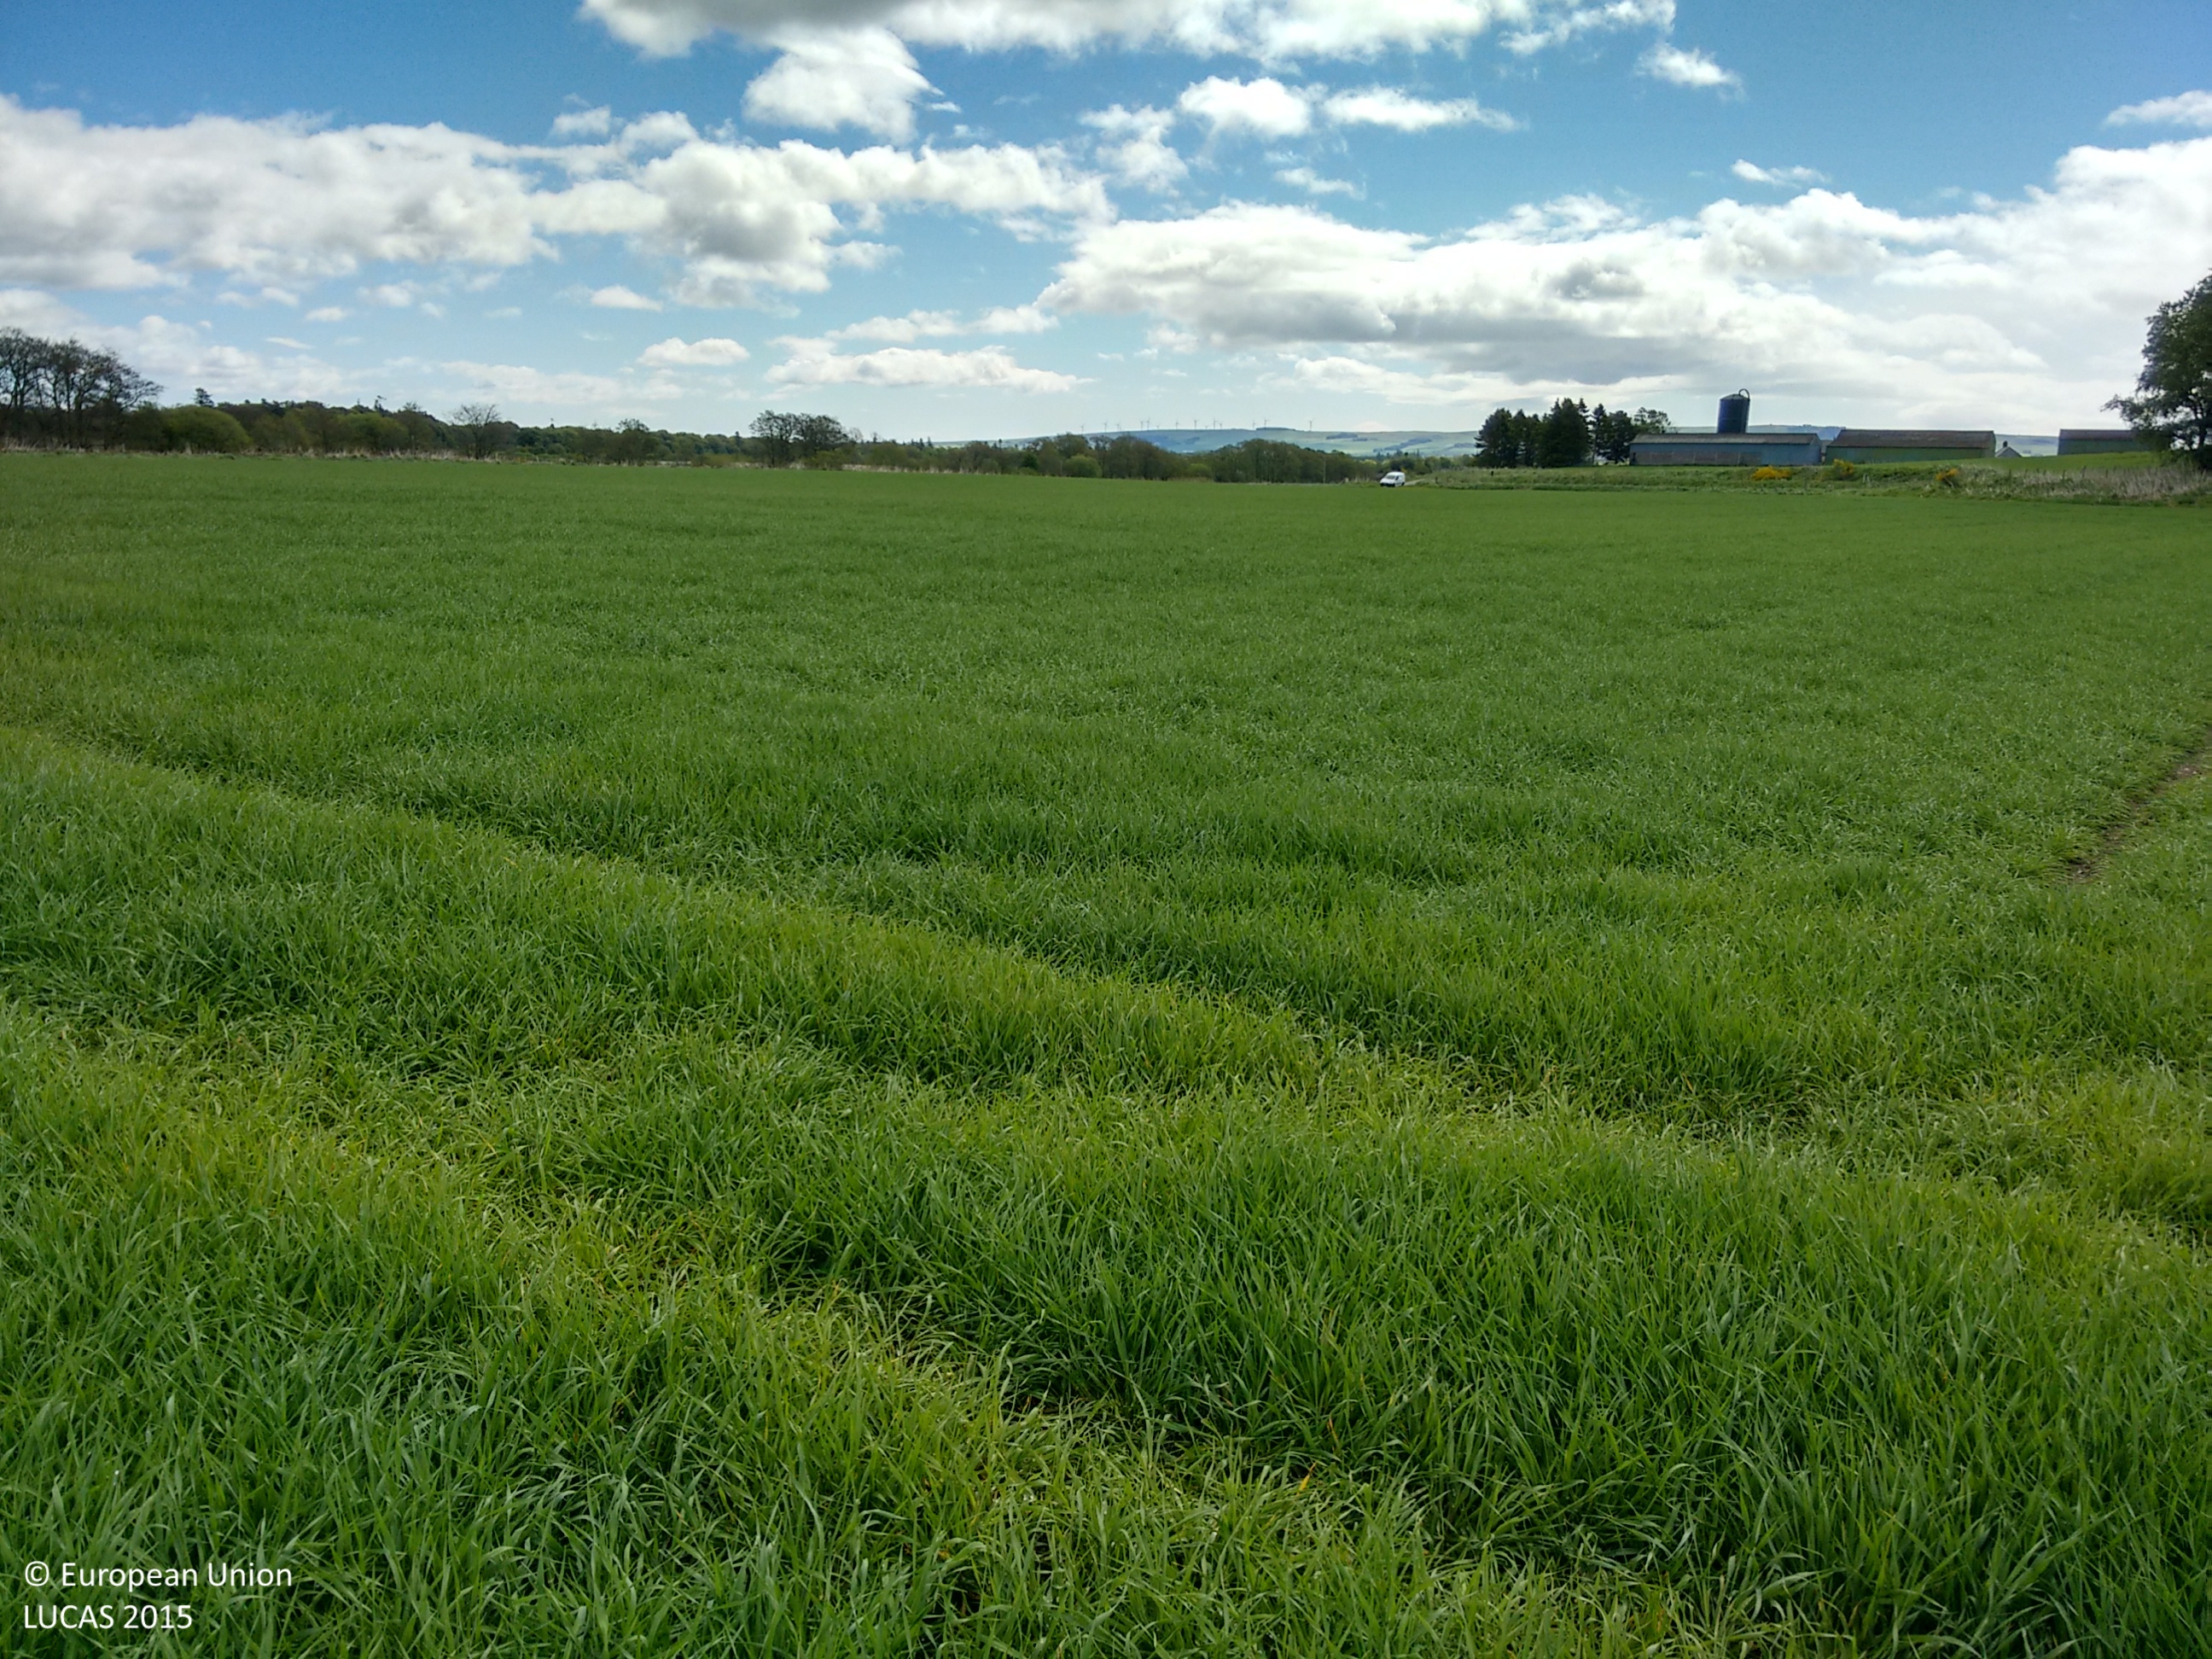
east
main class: Cropland
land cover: Barley
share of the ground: > 75 %
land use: Agriculture (excluding fallow land and kitchen gardens)
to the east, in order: Barley; Grass margins; Paved roads, cycling and walking lanes; Grass margins; Single bushes/trees; Dry stone walls; Shruby margins; Fences; Grass margins; Barley
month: June
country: GB
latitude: 56.8573
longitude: -2.6034
